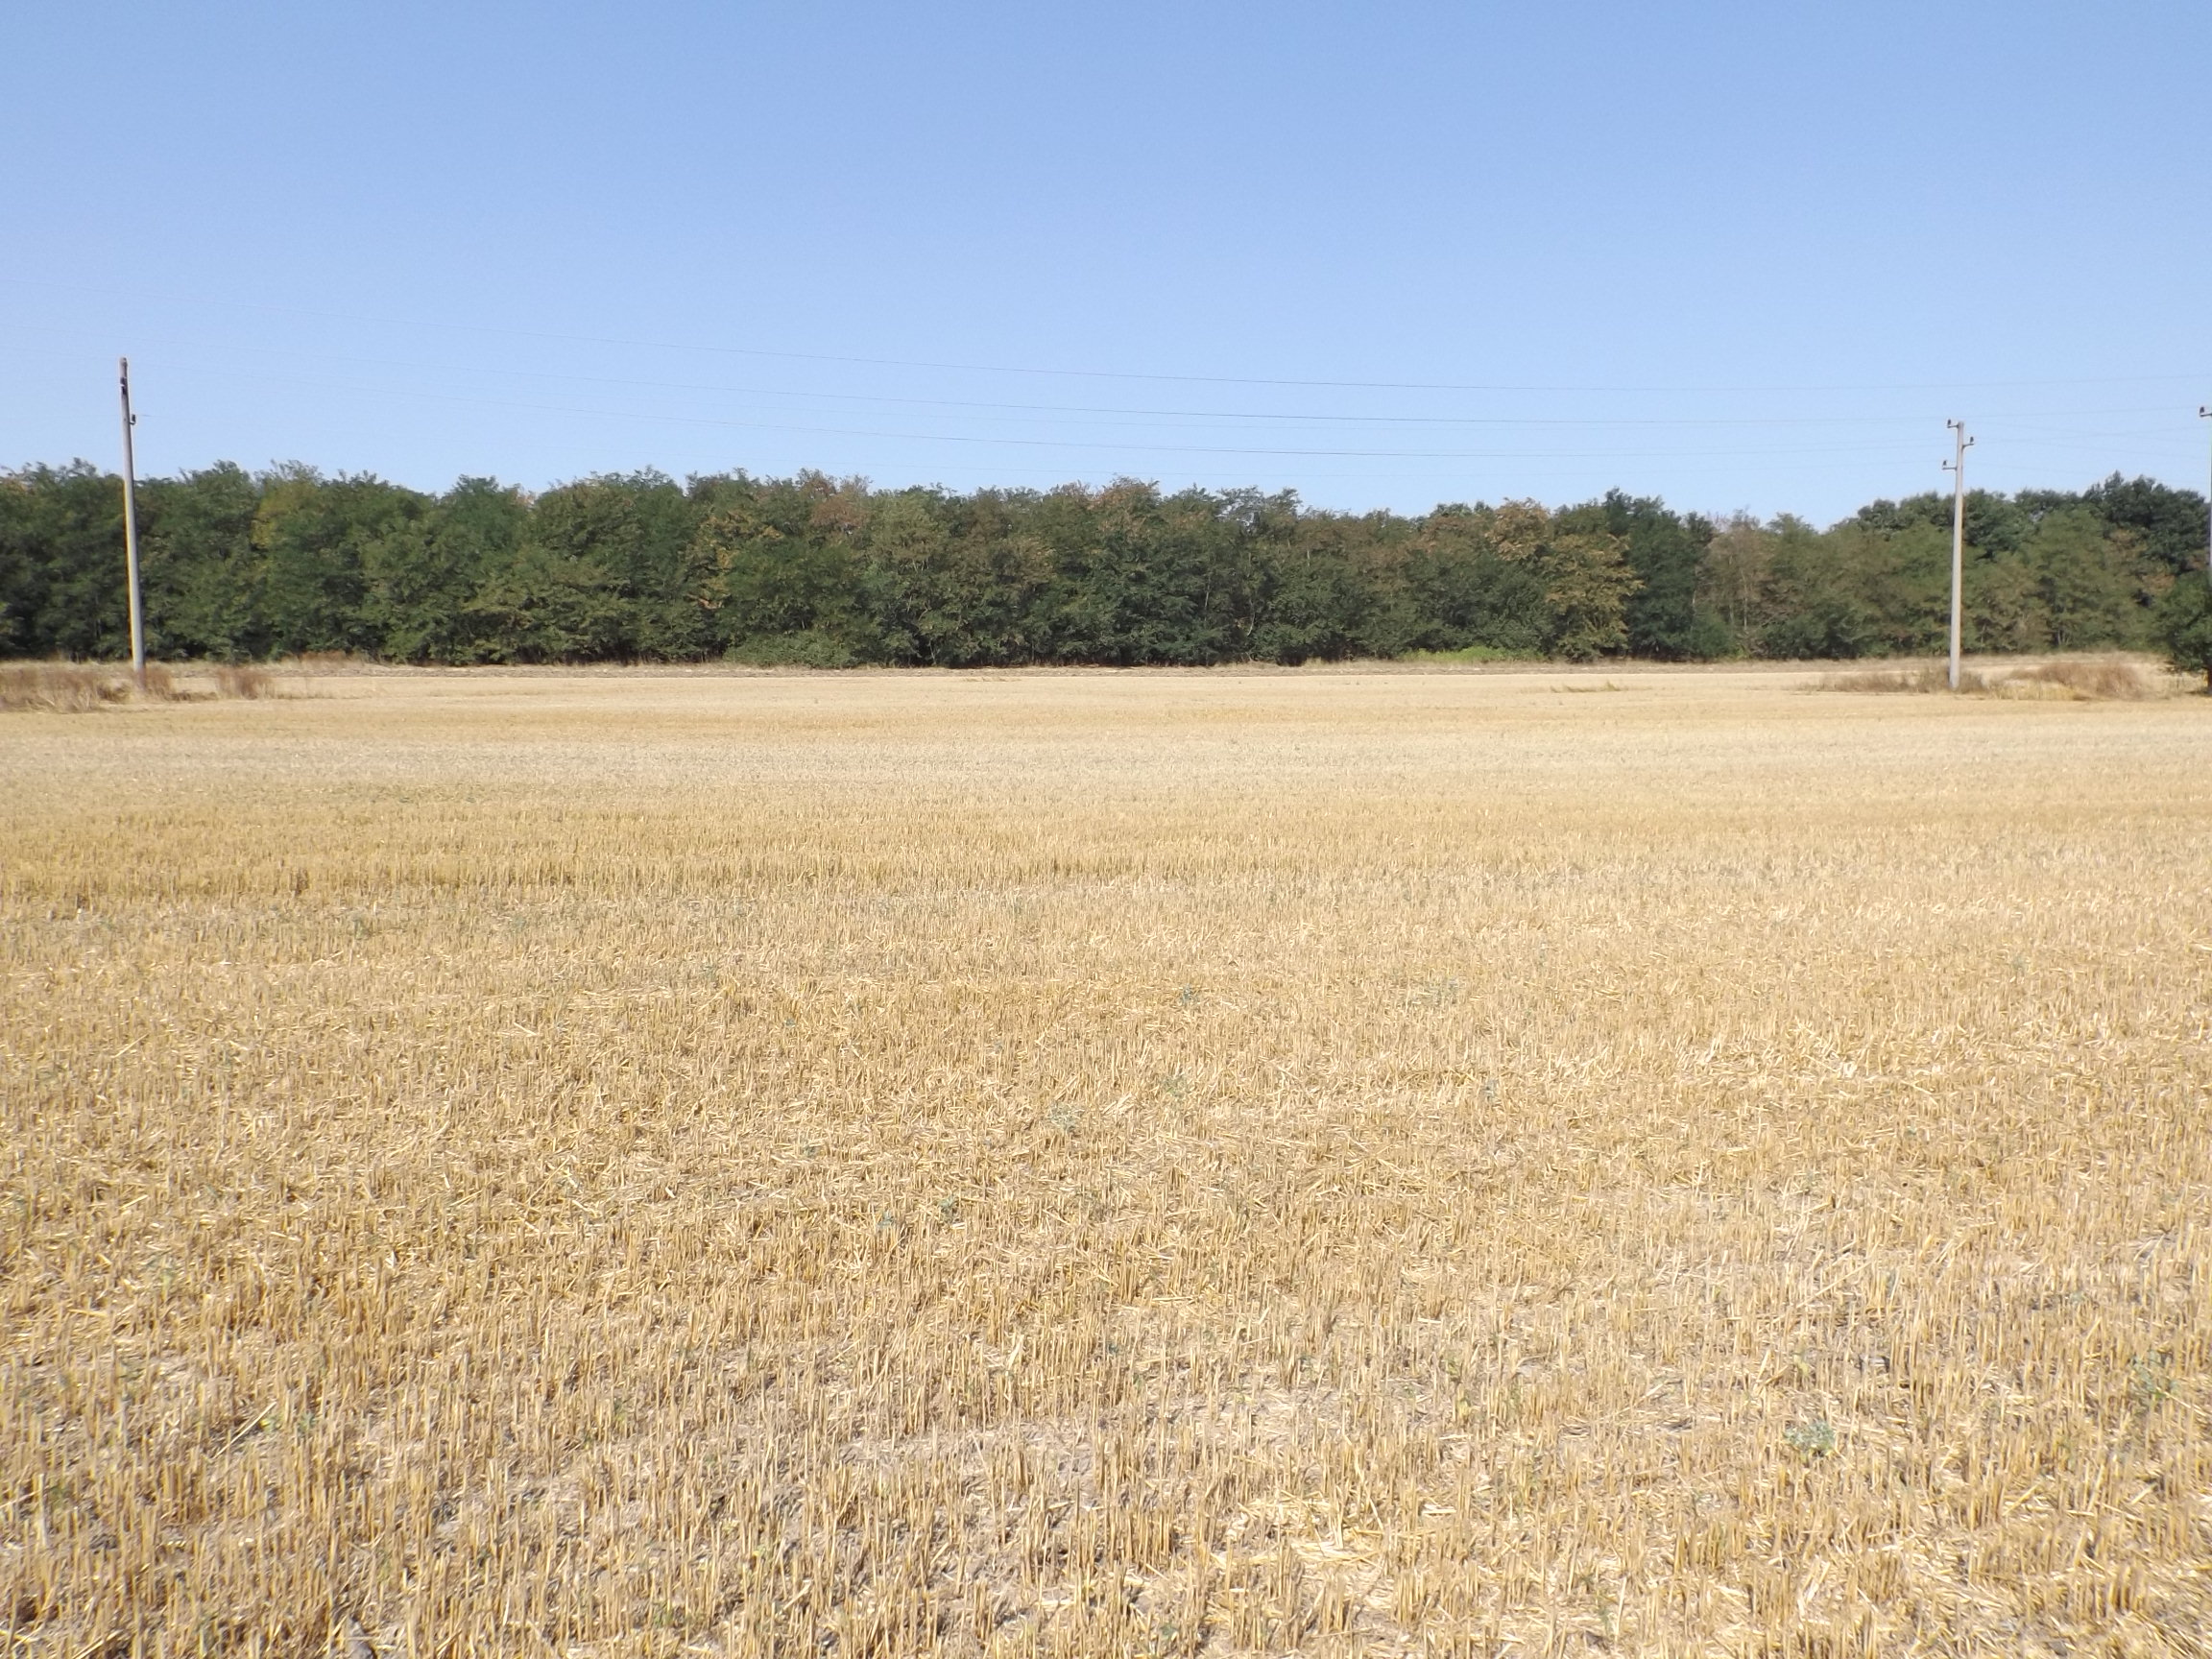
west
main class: Cropland
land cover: Common wheat
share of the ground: 25 - 50 %
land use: Agriculture (excluding fallow land and kitchen gardens)
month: August
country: BG
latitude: 43.4323
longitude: 27.5376
